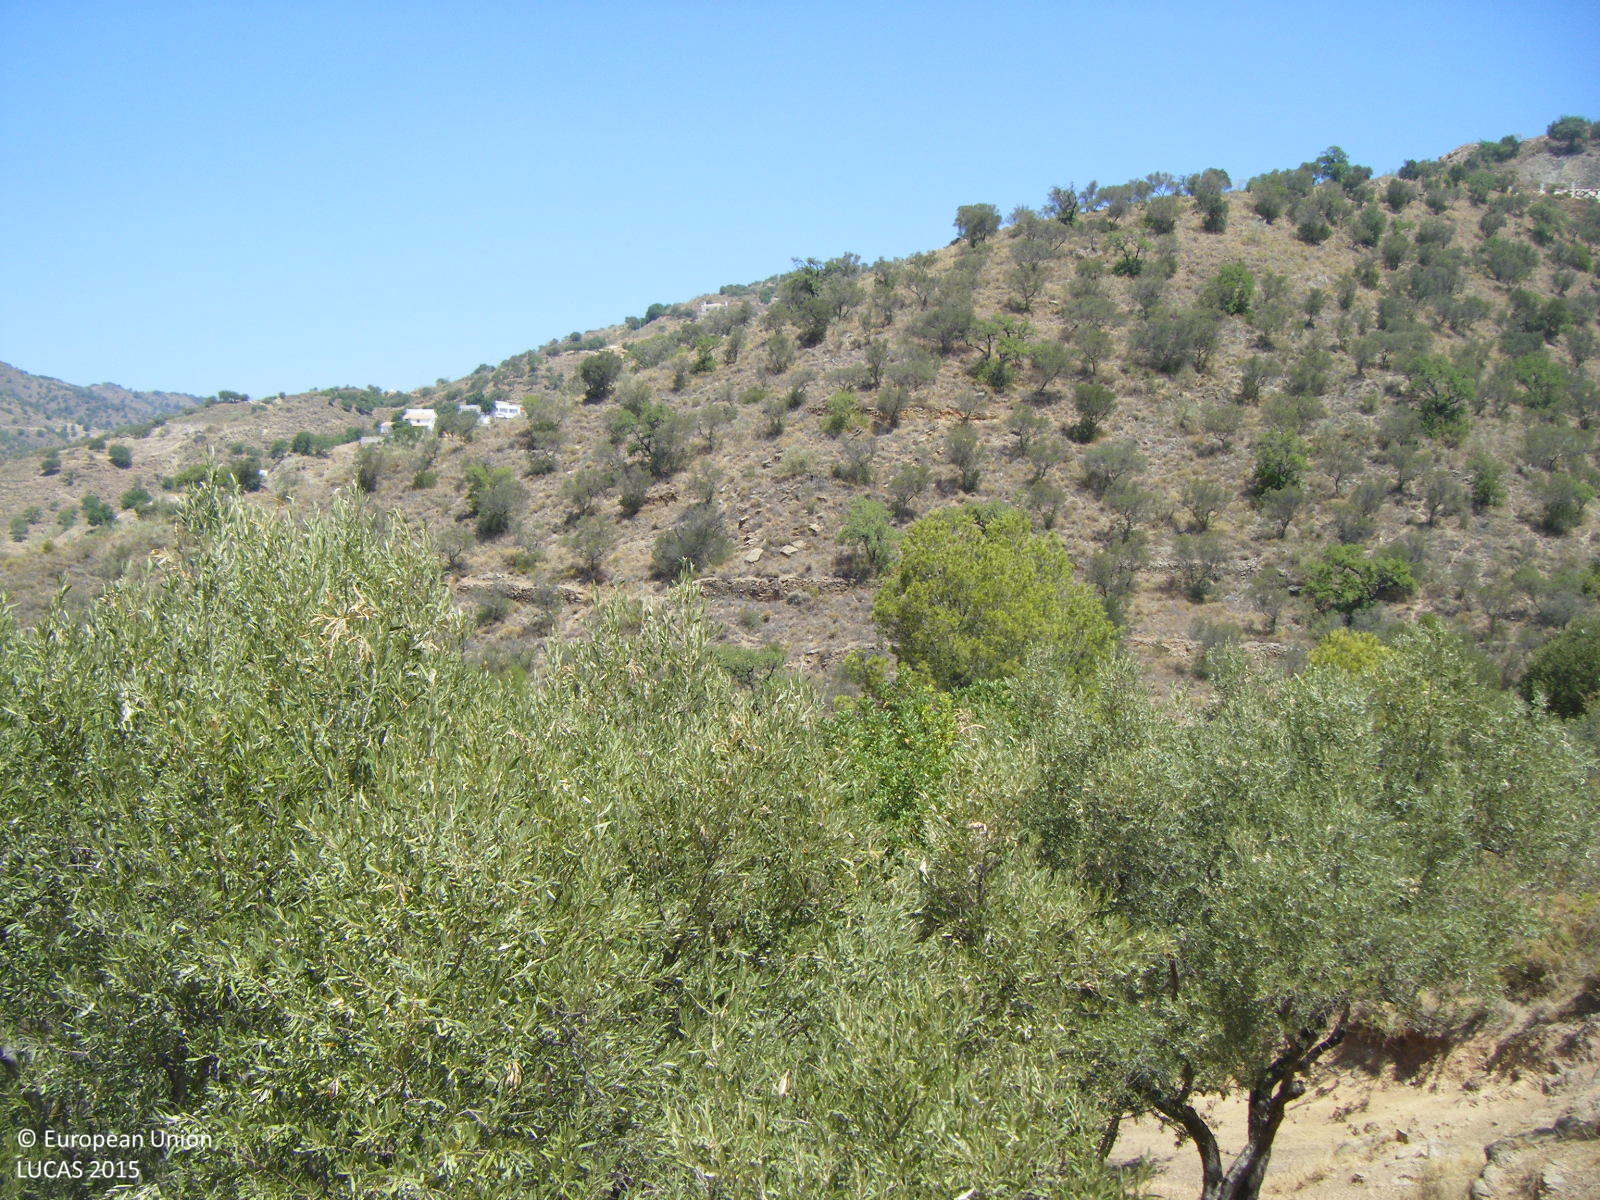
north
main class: Cropland
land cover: Olive groves
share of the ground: 10 - 25 %
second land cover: Spontaneously vegetated surfaces
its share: > 75 %
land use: Agriculture (excluding fallow land and kitchen gardens)
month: July
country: ES
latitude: 36.7471
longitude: -4.3366
